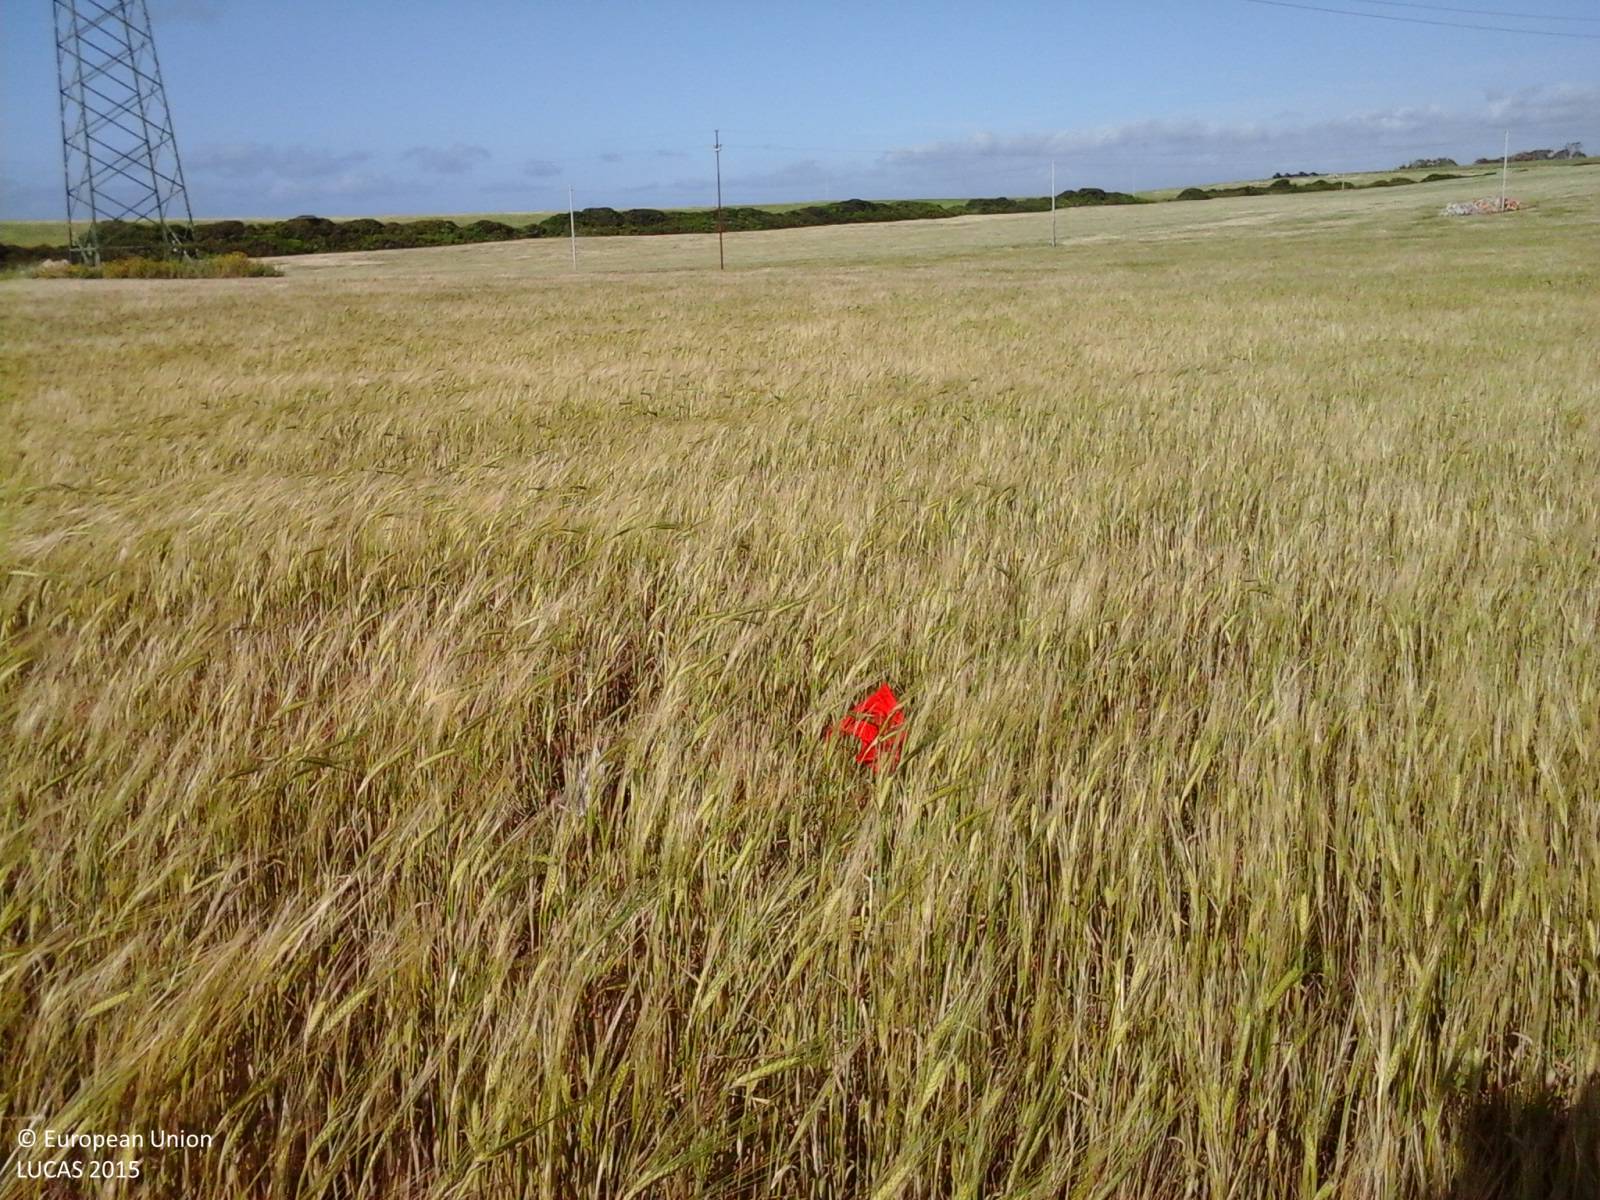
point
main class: Cropland
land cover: Barley
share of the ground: > 75 %
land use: Agriculture (excluding fallow land and kitchen gardens)
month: May
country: IT
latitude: 40.7982
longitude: 8.4547
